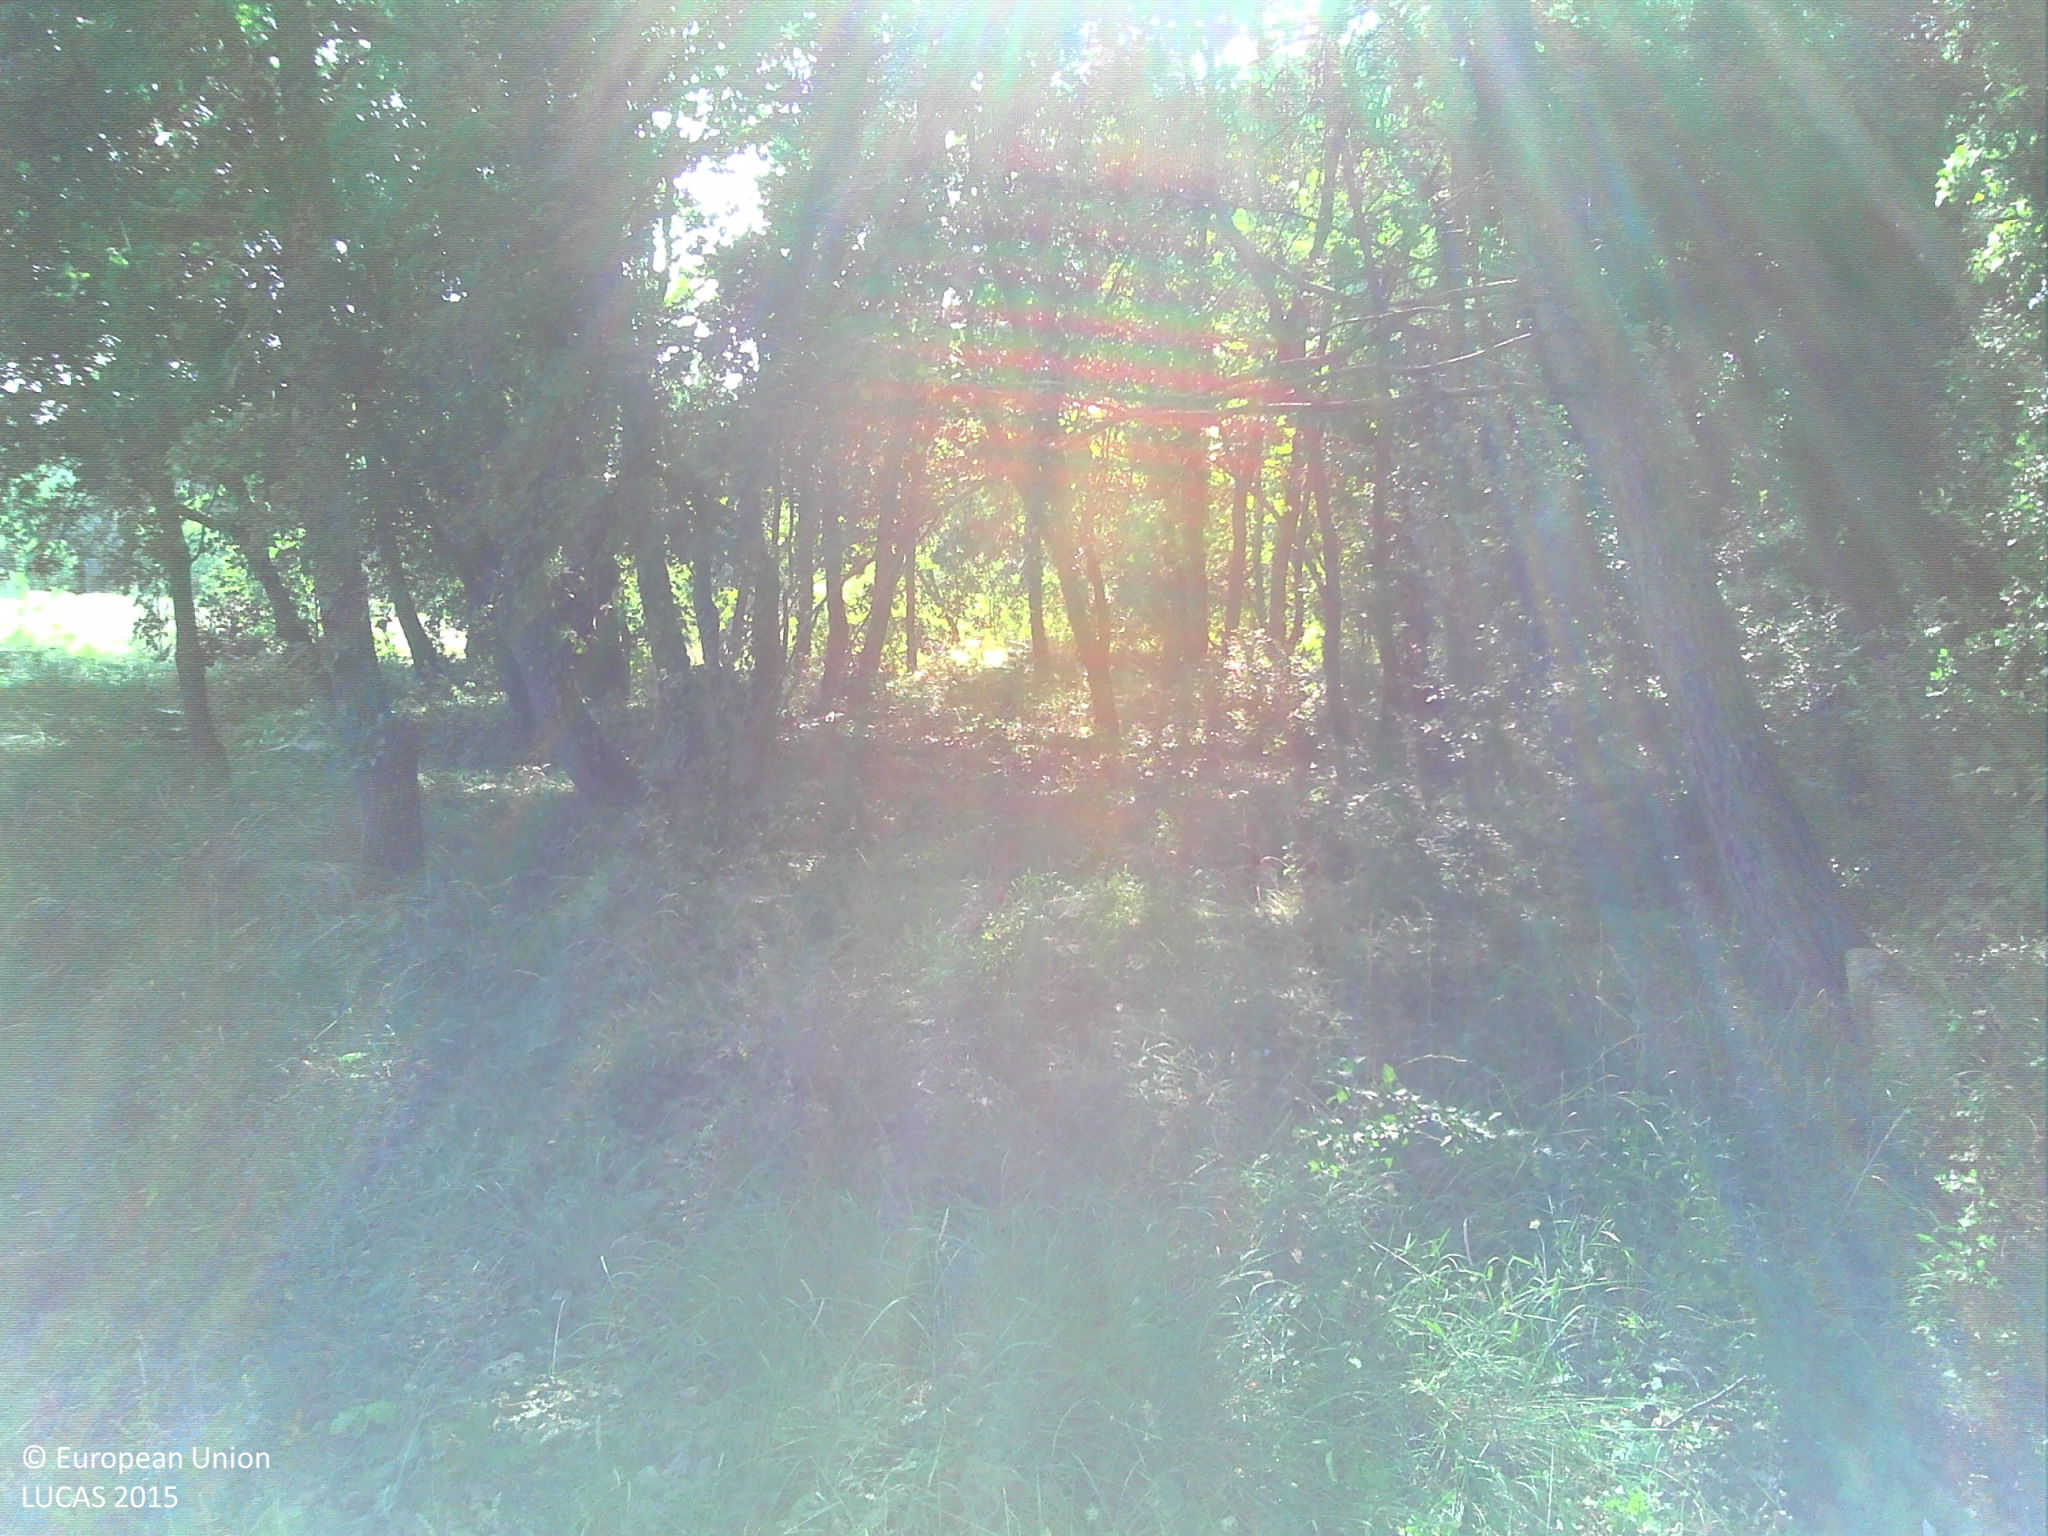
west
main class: Woodland
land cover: Broadleaved woodland
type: thermophilous deciduous forest
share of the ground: > 75 %
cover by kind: broadleaved forest trees 60 %, herbaceous plants 20 %, unconsolidated bare surface 10 %, coniferous forest trees 5 %, shrubs 5 %
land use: Forestry
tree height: > 5 m
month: October
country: FR
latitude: 44.0903
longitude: 5.0997
